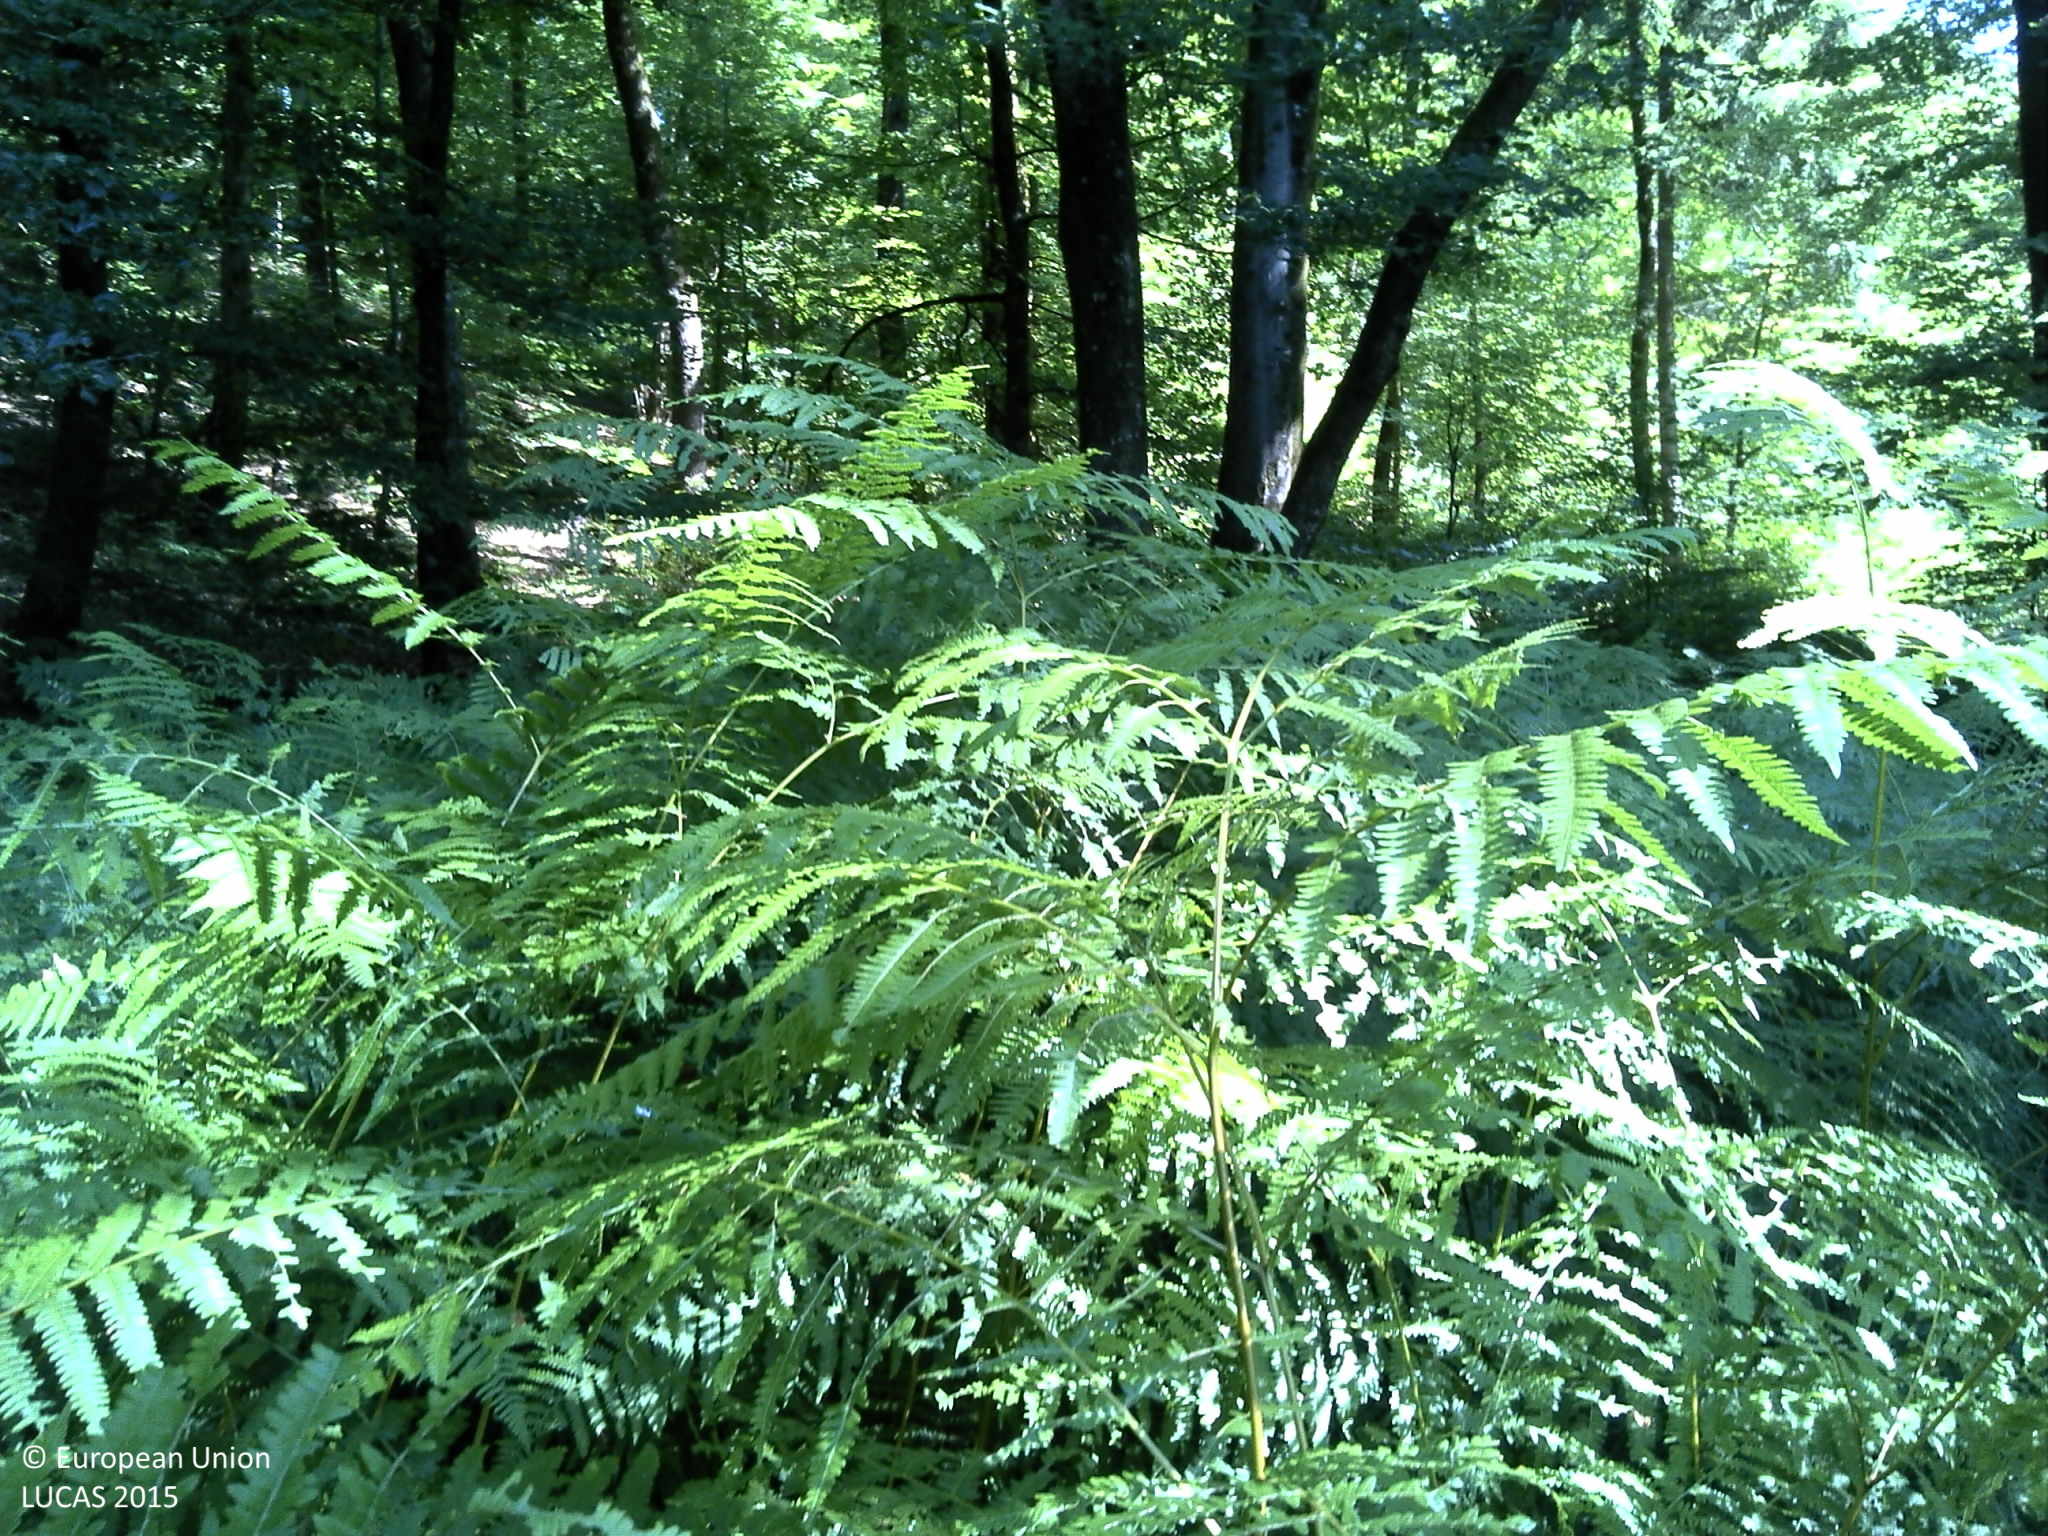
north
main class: Woodland
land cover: Broadleaved woodland
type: beech forest
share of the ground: > 75 %
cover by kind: broadleaved forest trees 100 %
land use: Forestry
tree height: > 5 m
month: July
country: FR
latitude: 48.1154
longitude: 6.0110
